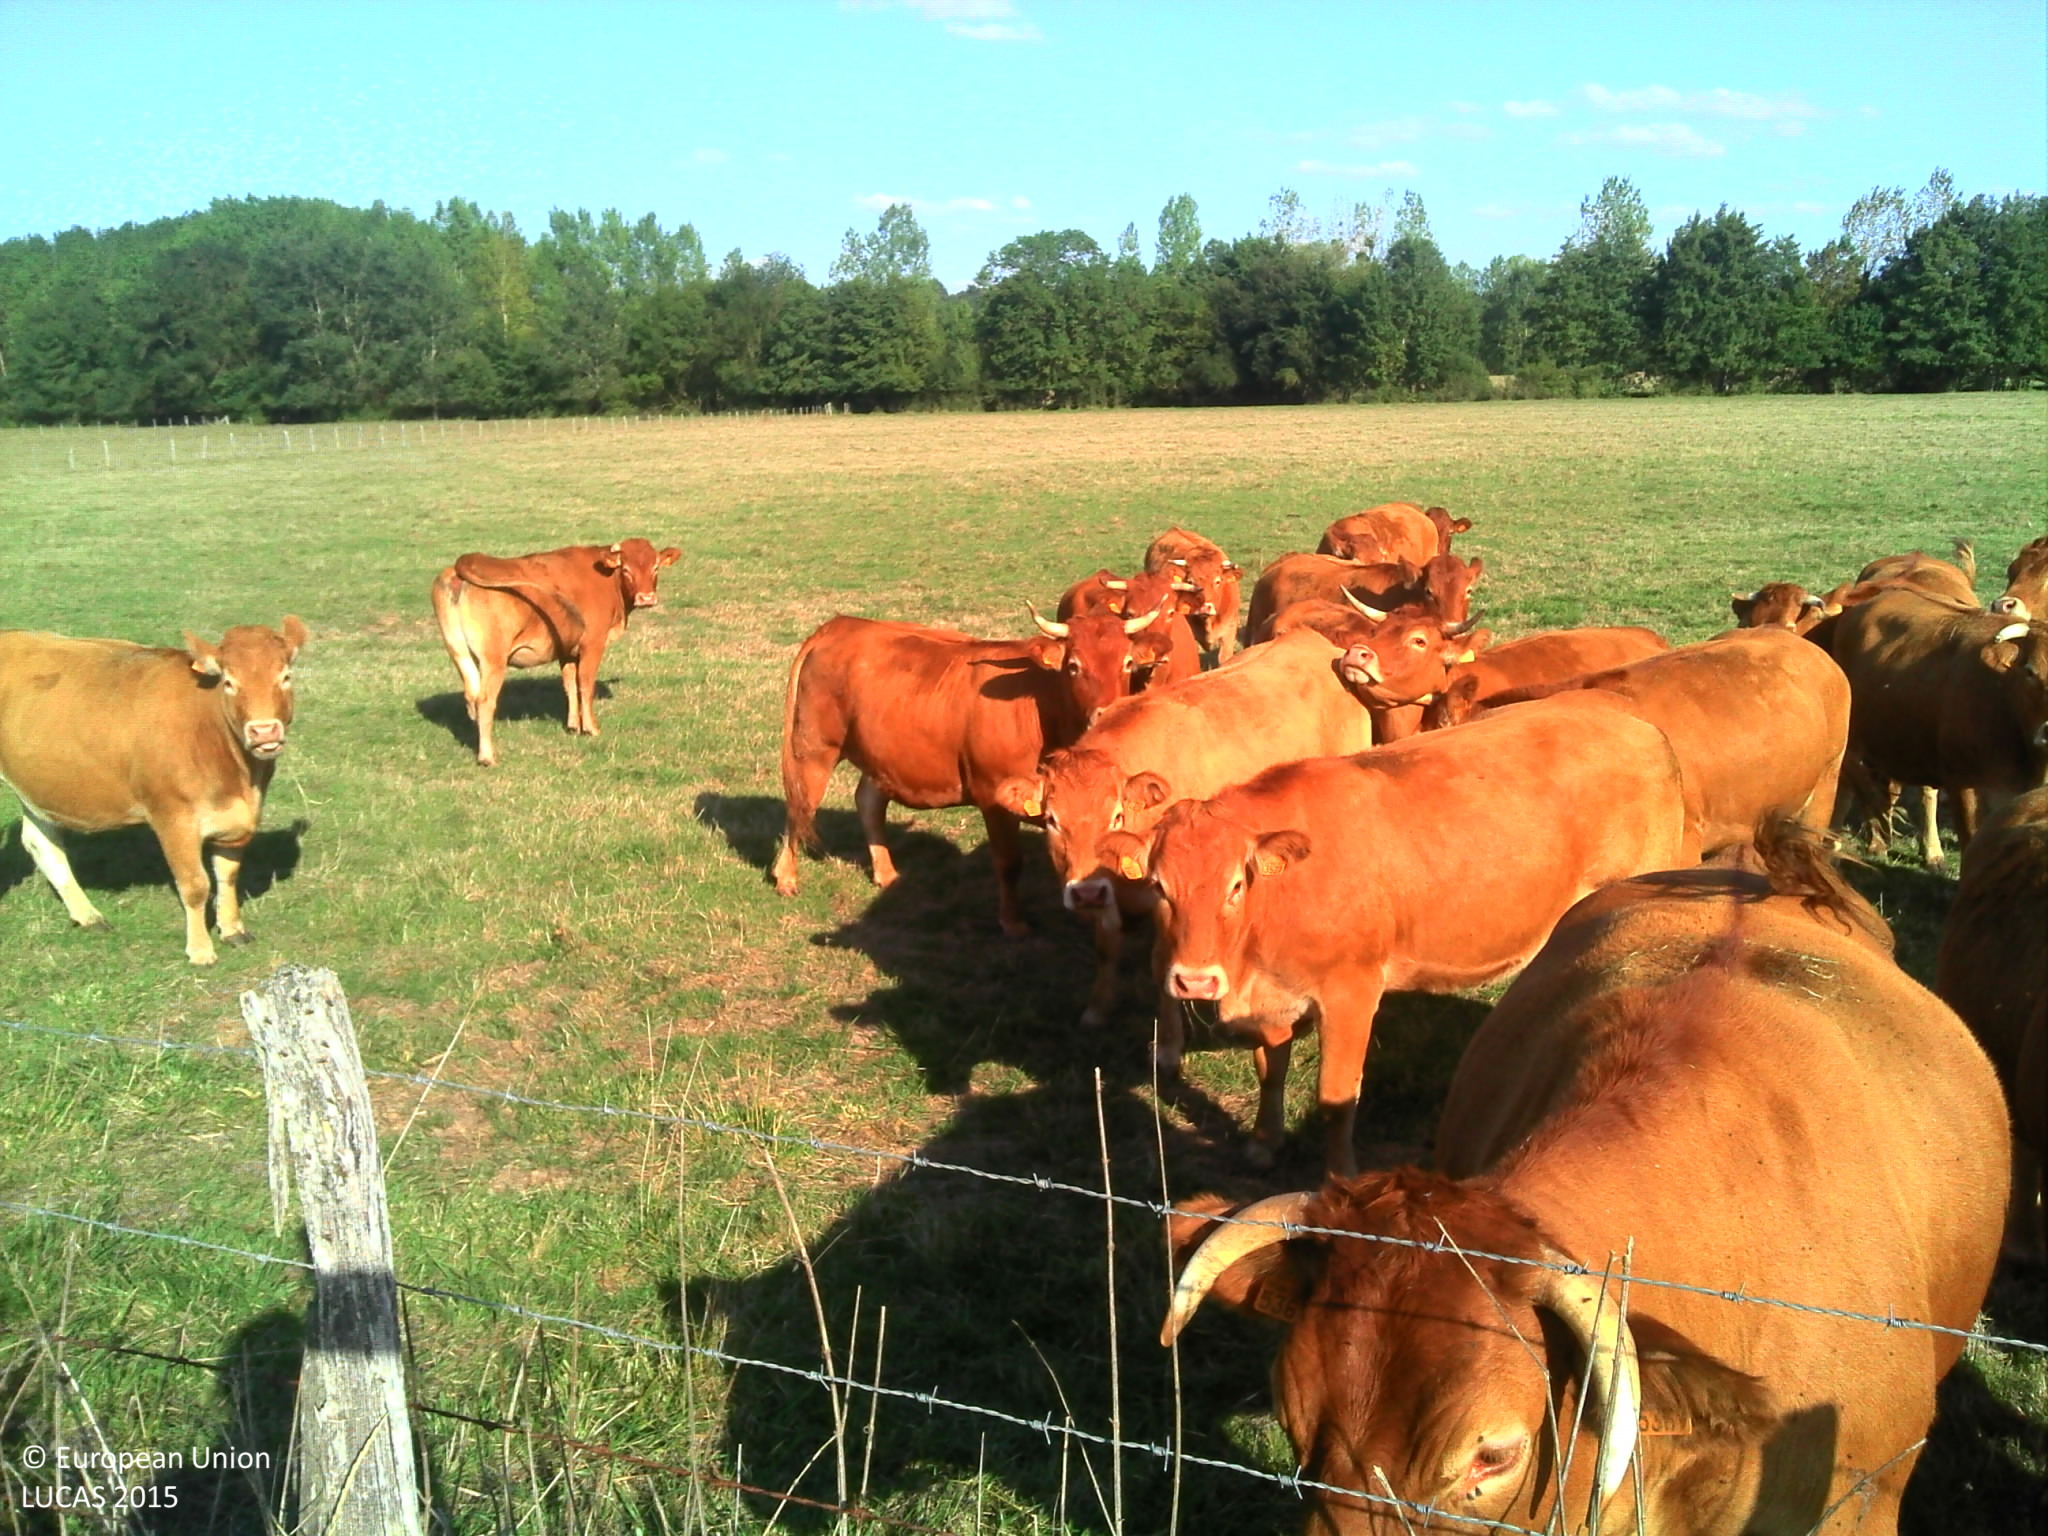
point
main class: Grassland
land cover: Grassland without tree/shrub cover
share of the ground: > 75 %
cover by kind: herbaceous plants 95 %, unconsolidated bare surface 5 %
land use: Agriculture (excluding fallow land and kitchen gardens)
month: September
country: FR
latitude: 47.0641
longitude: 1.5215
